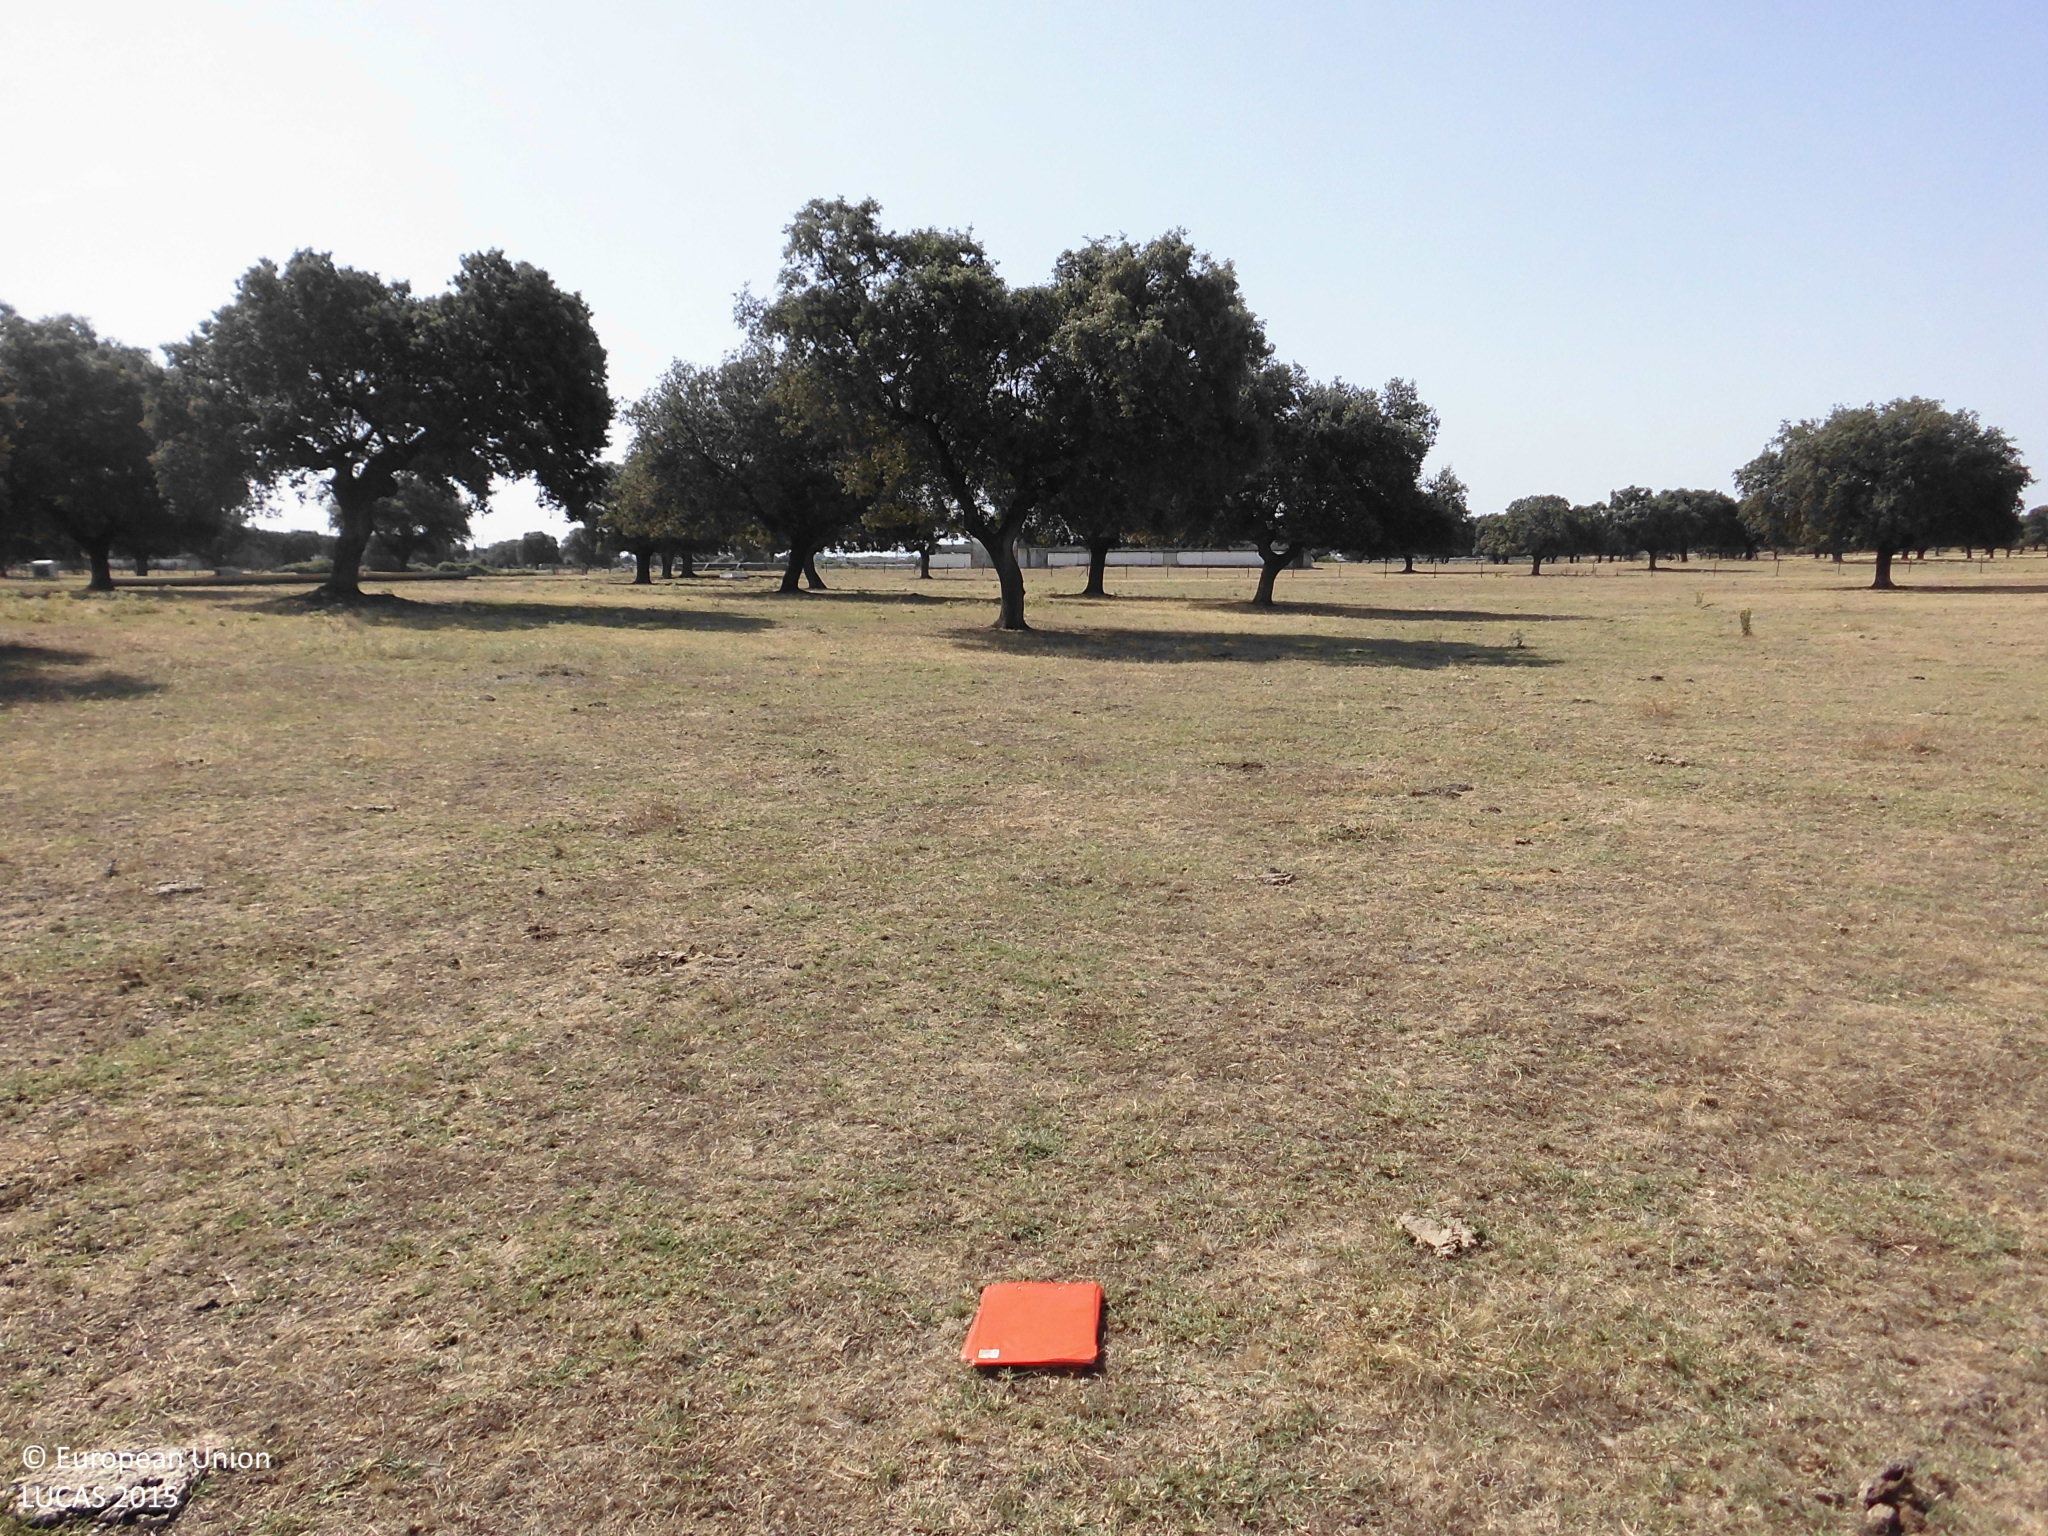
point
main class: Woodland
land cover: Broadleaved woodland
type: broadleaved evergreen forest
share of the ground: 10 - 25 %
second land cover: Grassland without tree/shrub cover
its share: > 75 %
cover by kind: herbaceous plants 90 %, broadleaved forest trees 10 %
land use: Forestry
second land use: Agriculture (excluding fallow land and kitchen gardens)
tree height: > 5 m
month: July
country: ES
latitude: 39.8937
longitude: -5.4838
